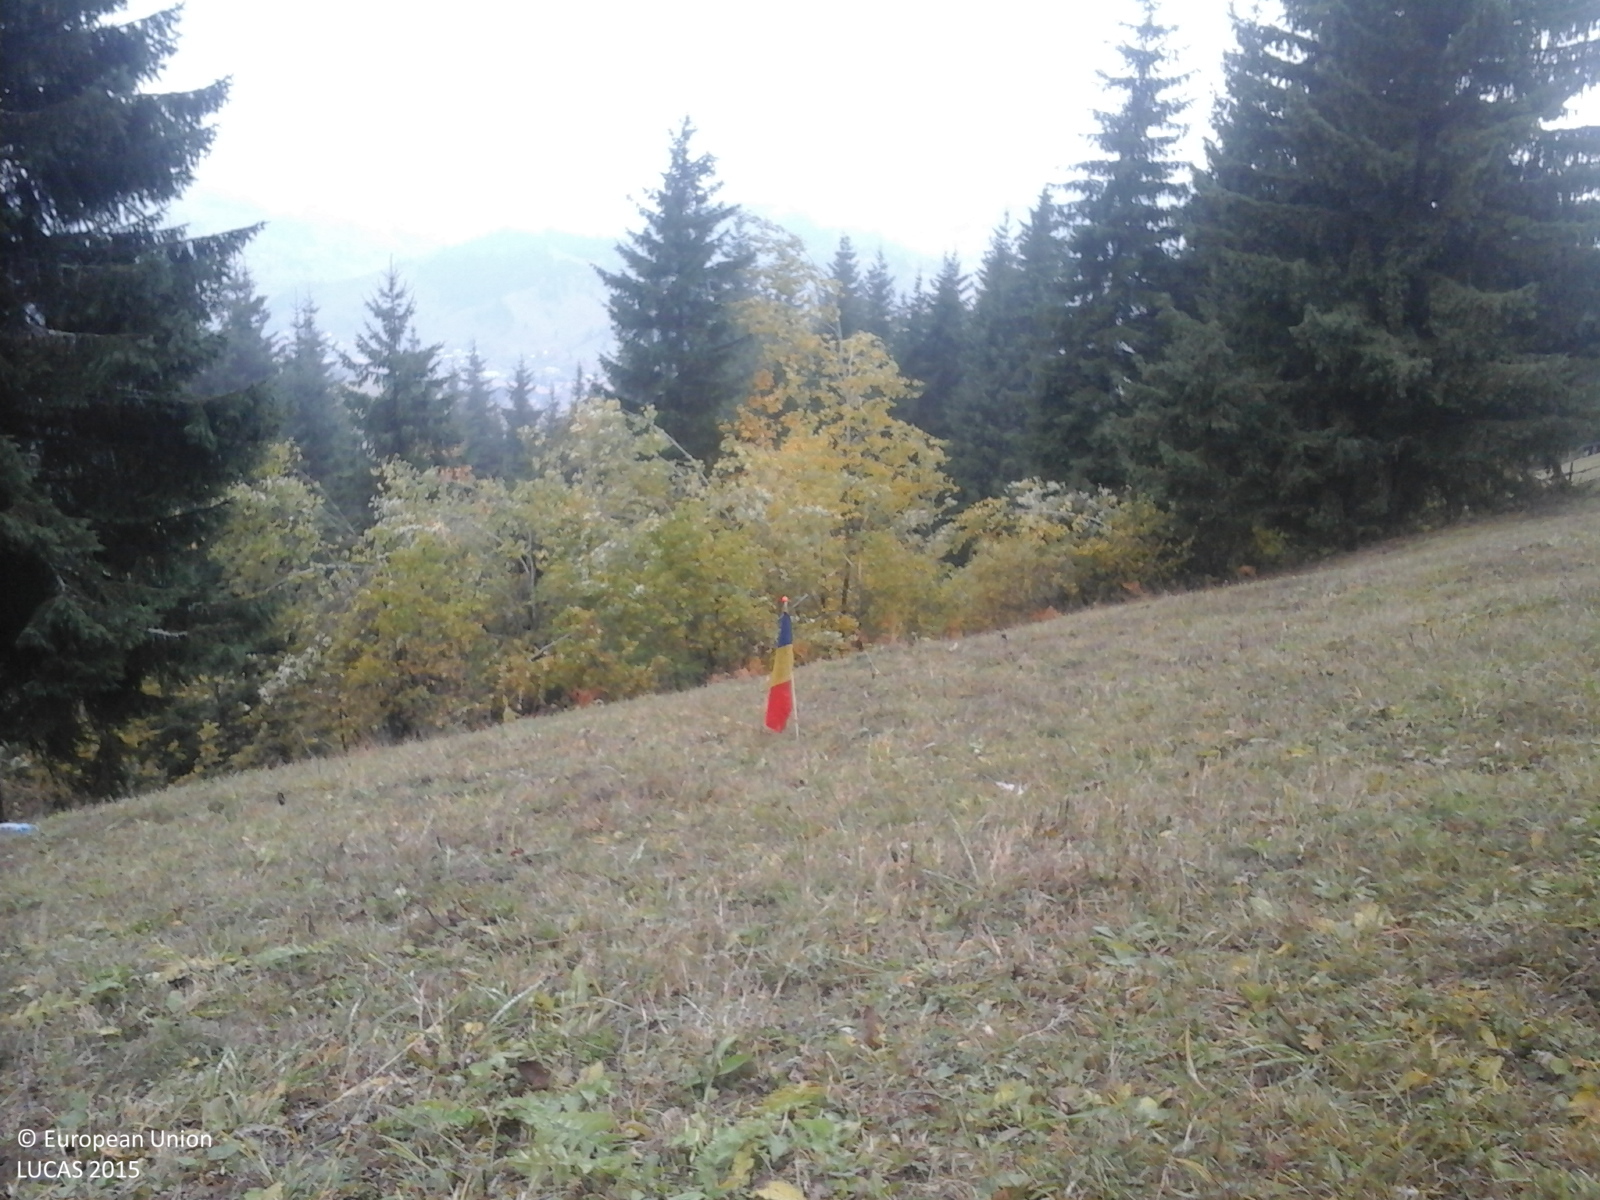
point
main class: Grassland
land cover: Grassland without tree/shrub cover
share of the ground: > 75 %
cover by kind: herbaceous plants 100 %
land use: Agriculture (excluding fallow land and kitchen gardens)
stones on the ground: < 10 %
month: October
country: RO
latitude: 46.5505
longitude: 25.9938
